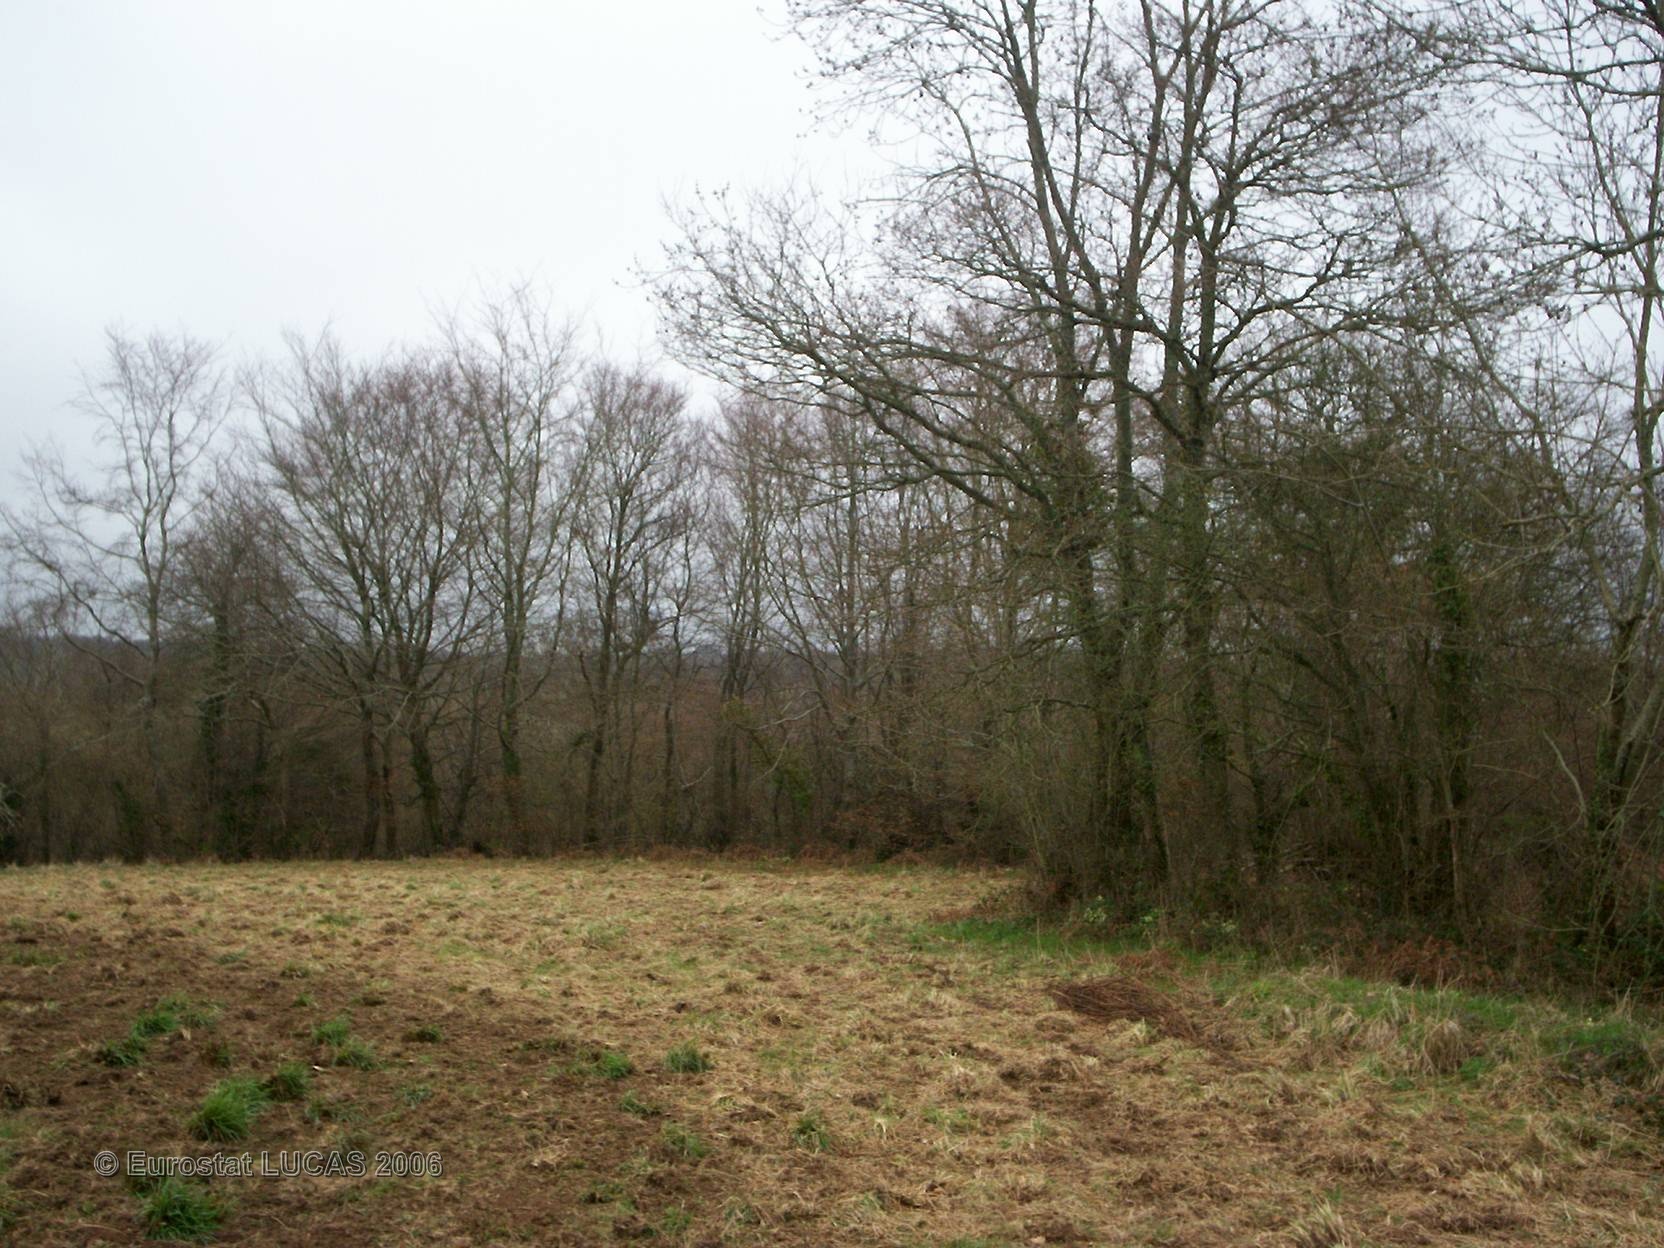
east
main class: Grassland
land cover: Grassland without tree/shrub cover
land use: Agriculture (excluding fallow land and kitchen gardens)
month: May
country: FR
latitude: 49.5187
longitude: -1.5847
